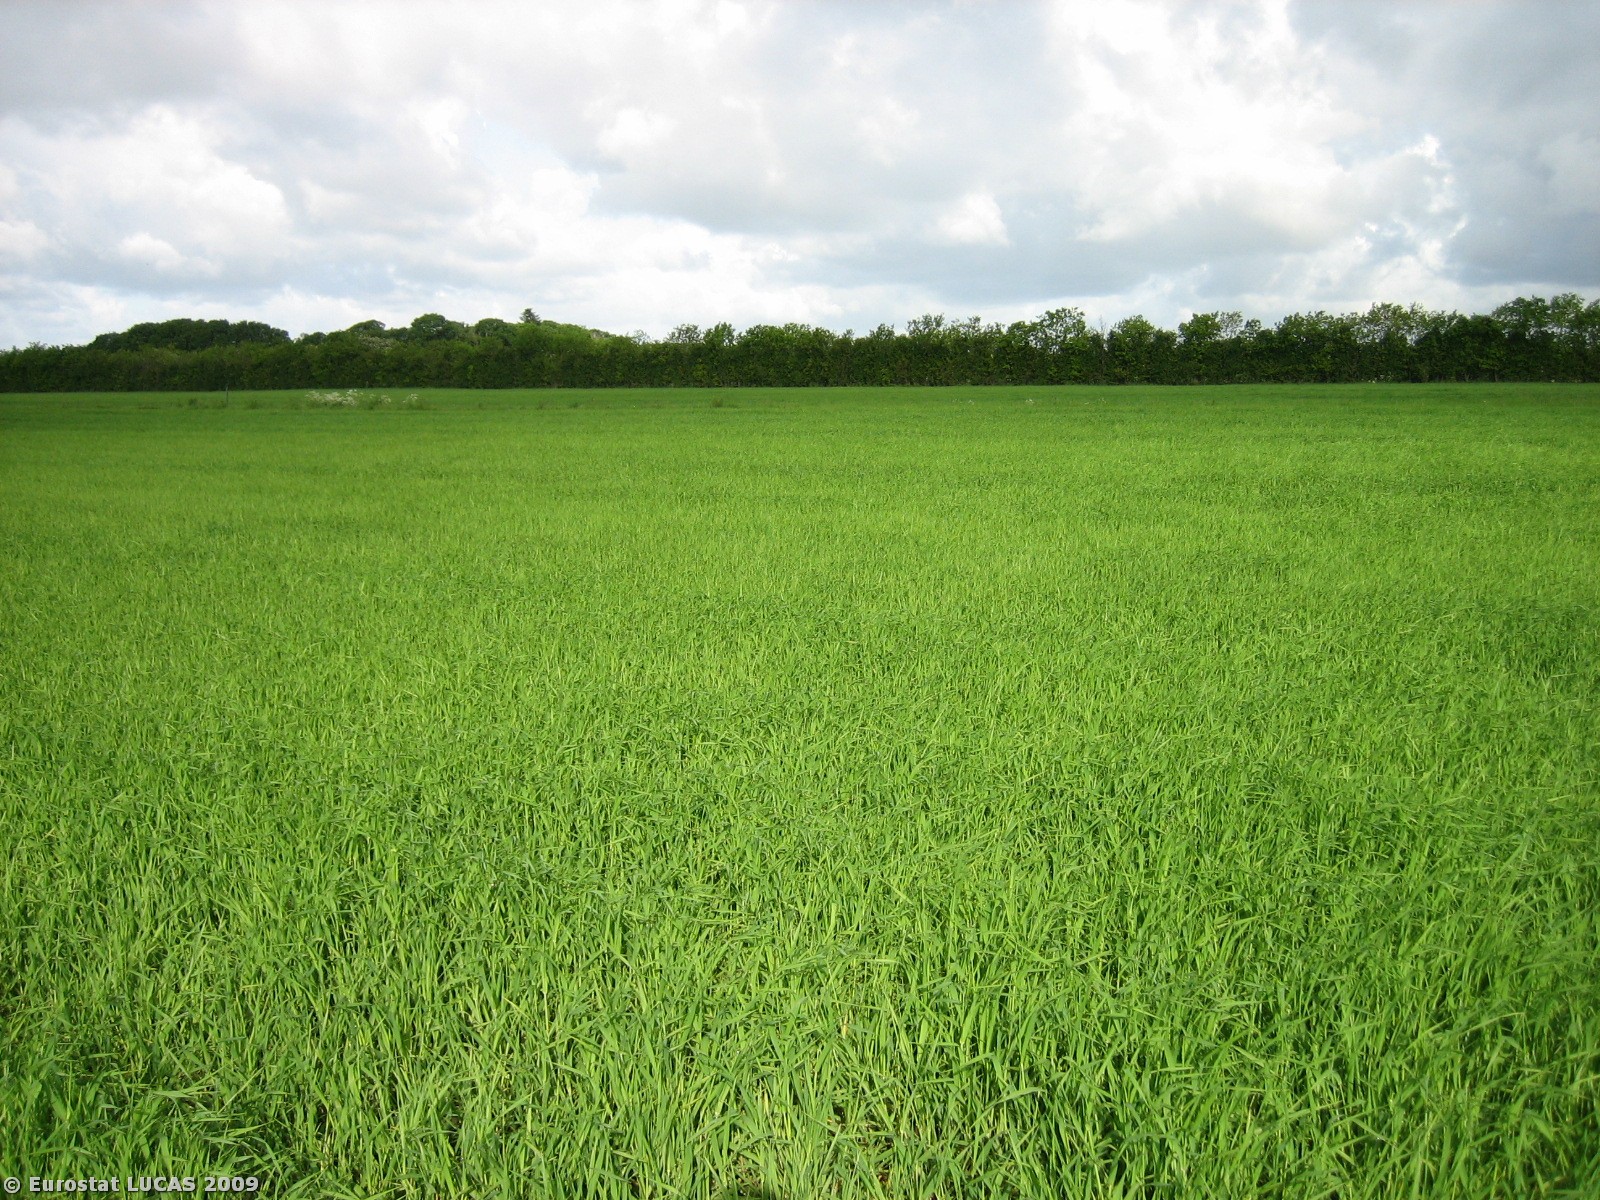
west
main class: Cropland
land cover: Barley
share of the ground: > 75 %
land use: Agriculture (excluding fallow land and kitchen gardens)
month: May
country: DK
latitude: 55.8977
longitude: 9.2172
